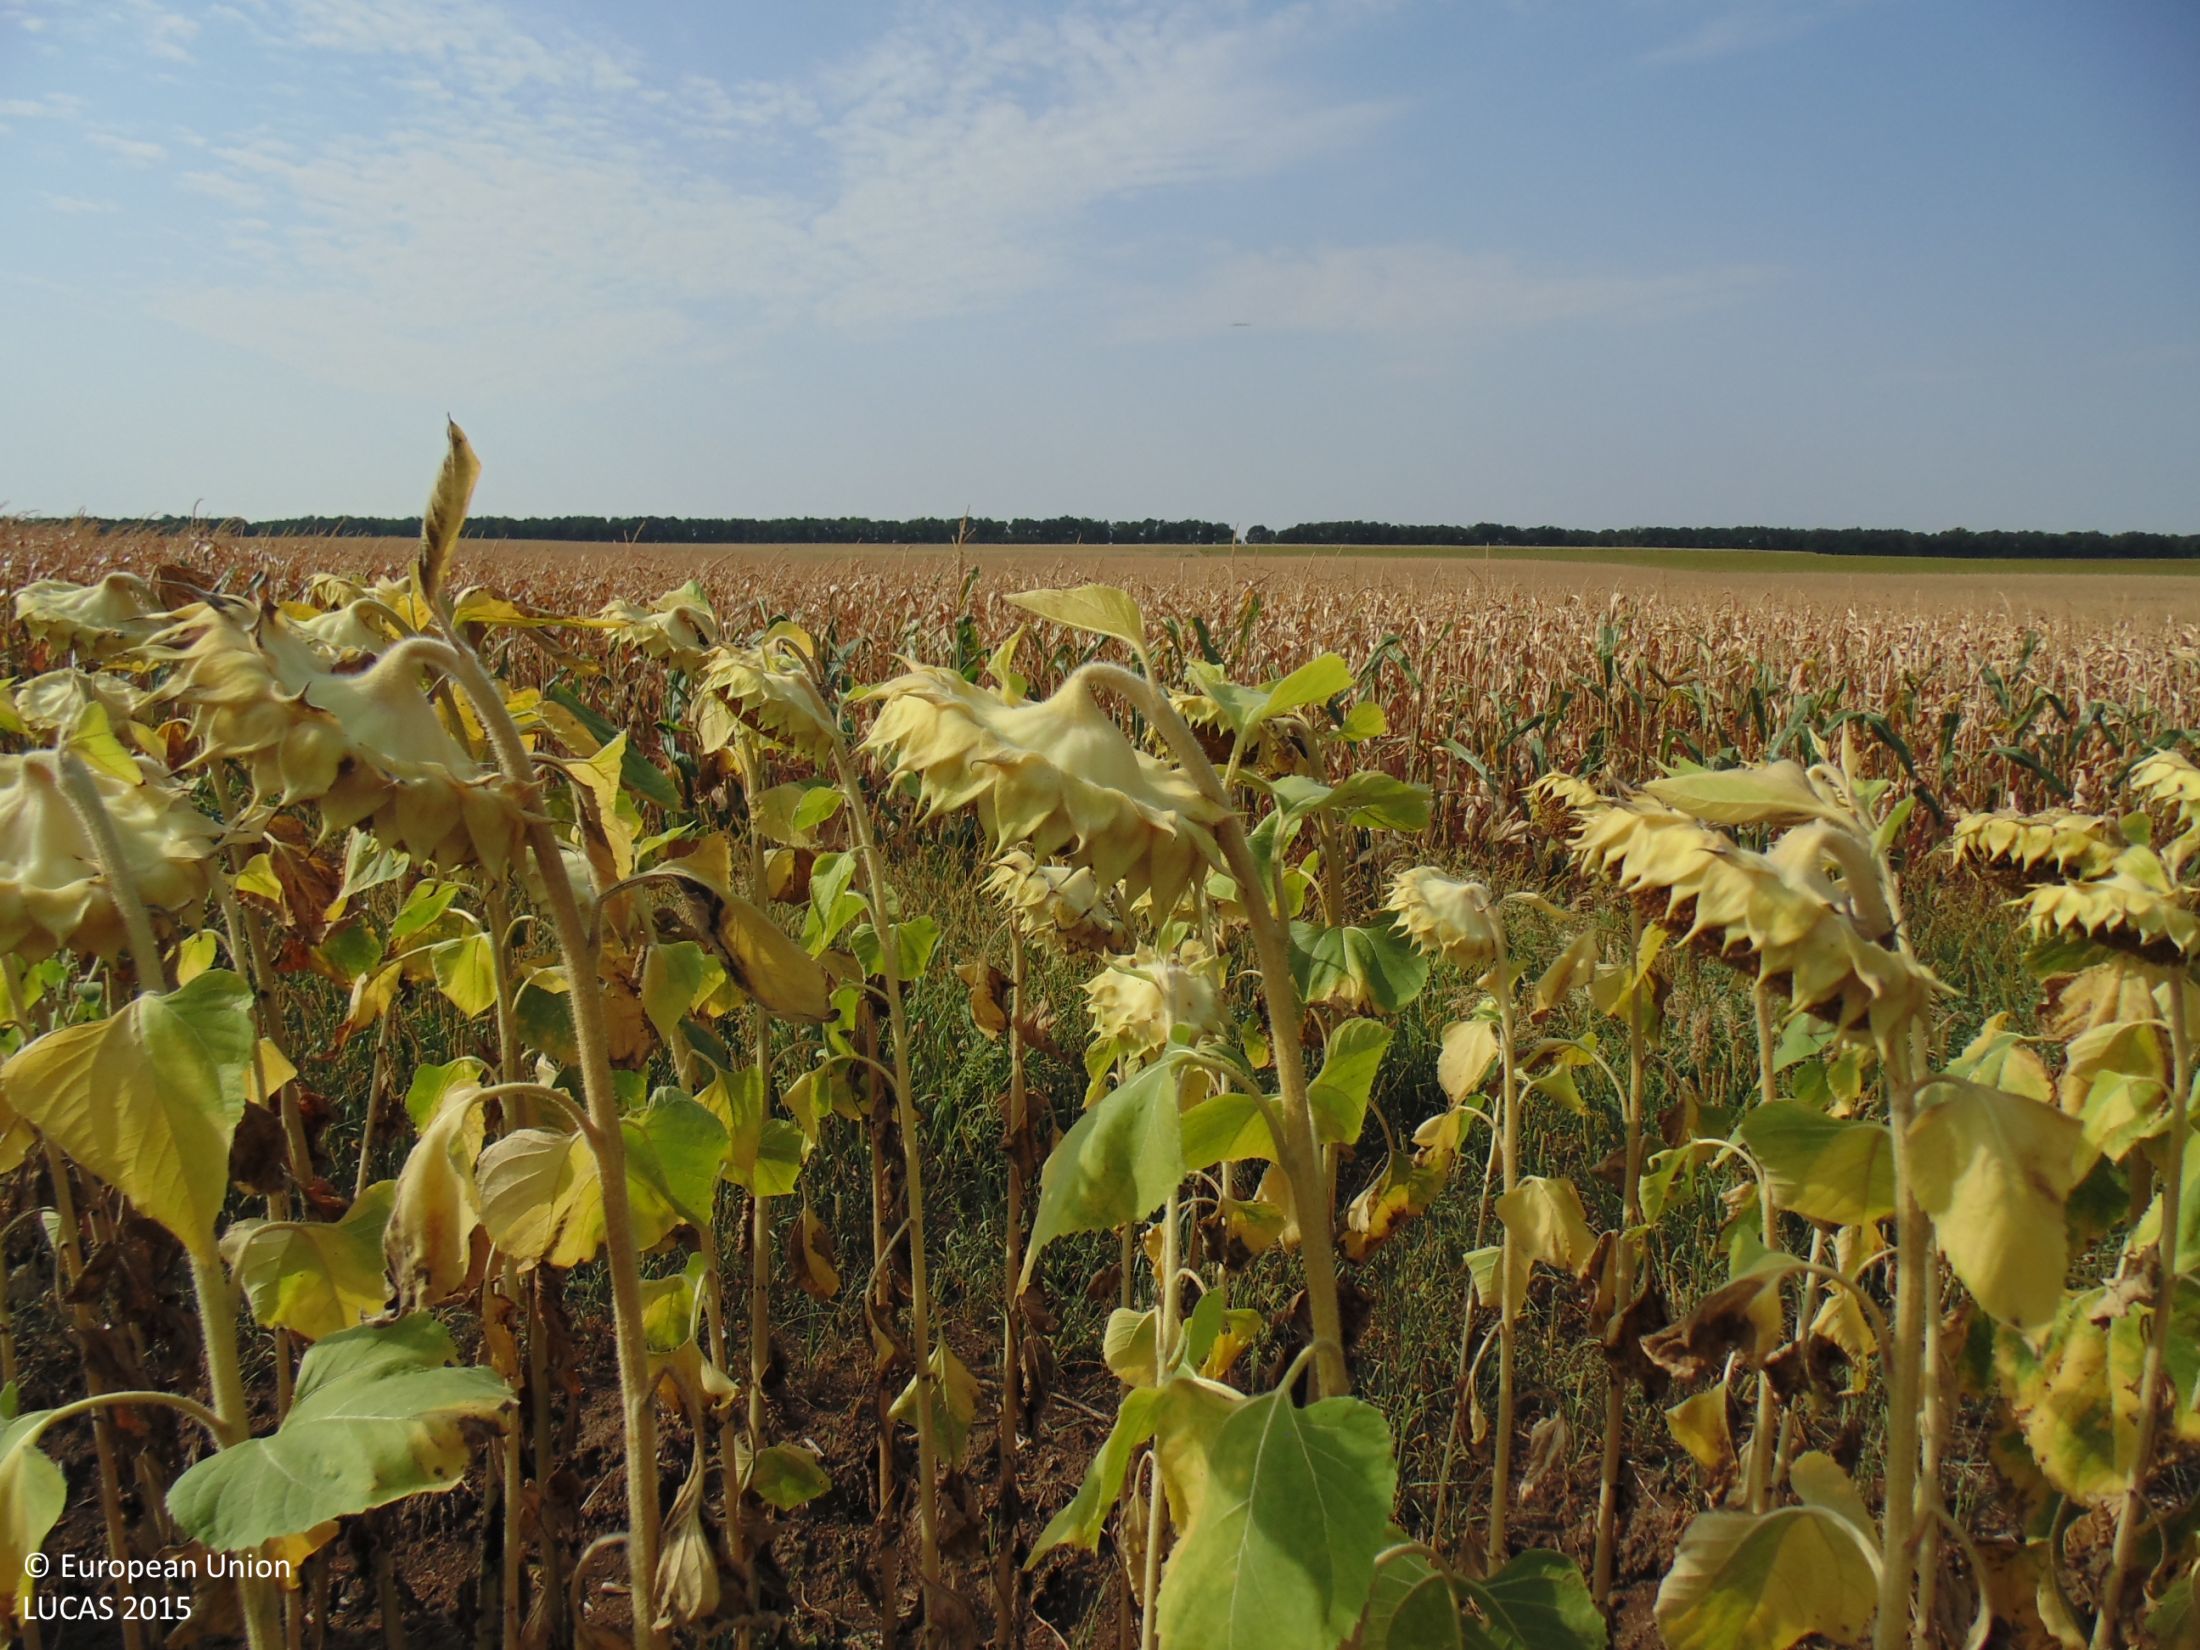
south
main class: Cropland
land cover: Sunflower
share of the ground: > 75 %
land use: Agriculture (excluding fallow land and kitchen gardens)
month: August
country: BG
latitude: 43.7253
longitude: 27.6540
